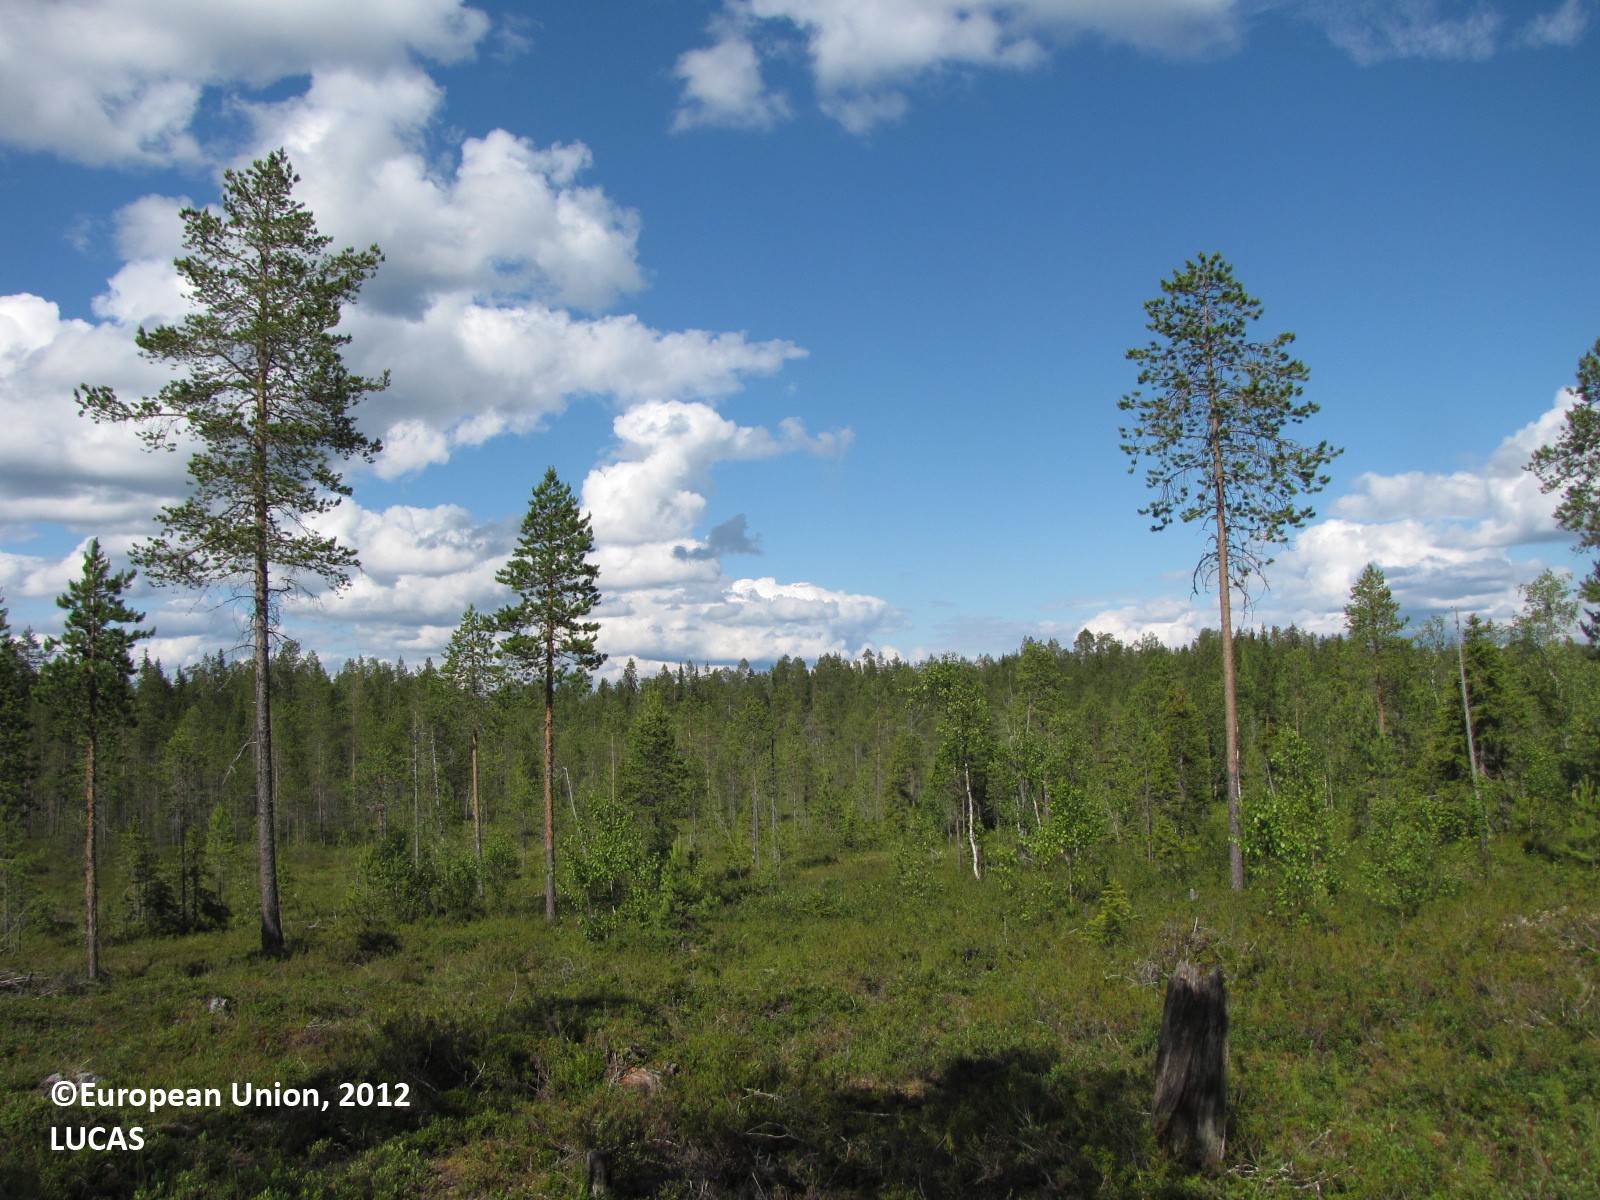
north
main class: Woodland
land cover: Pine dominated mixed woodland
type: boreal forest
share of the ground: 25 - 50 %
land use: Forestry
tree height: > 5 m
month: July
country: FI
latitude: 66.5278
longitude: 24.5571
